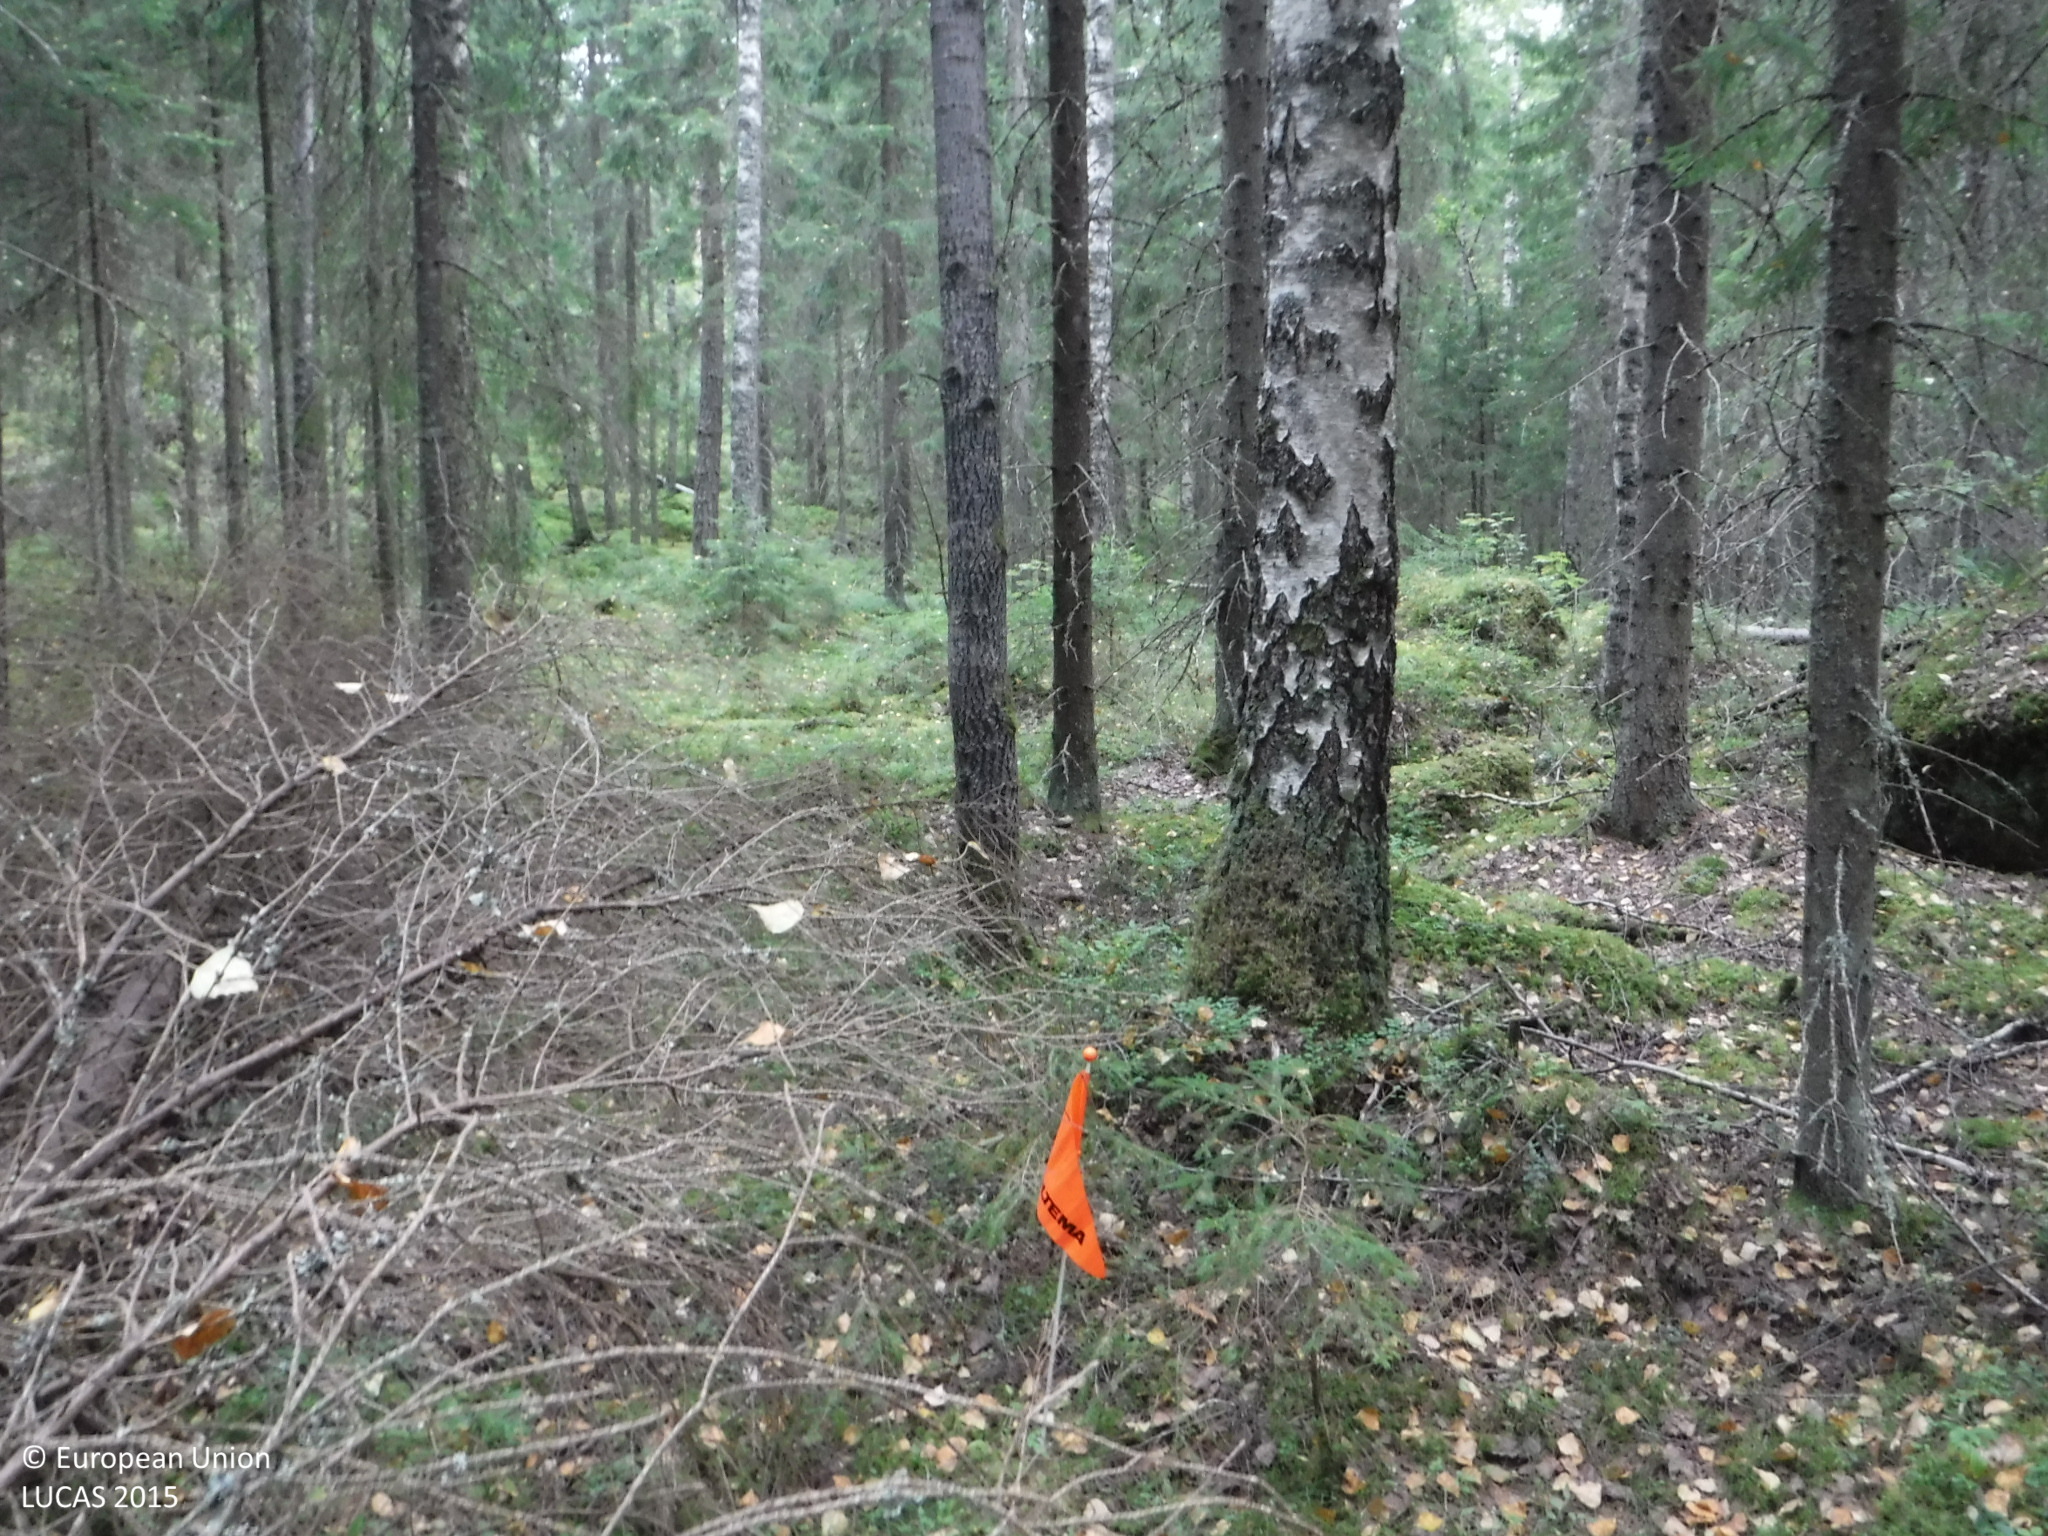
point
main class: Woodland
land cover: Spruce dominated mixed woodland
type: boreal forest
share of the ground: 50 - 75 %
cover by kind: coniferous forest trees 40 %, lichens and mosses 30 %, broadleaved forest trees 20 %, shrubs 10 %
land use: Forestry
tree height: > 5 m
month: August
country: FI
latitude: 61.2768
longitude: 22.9994
